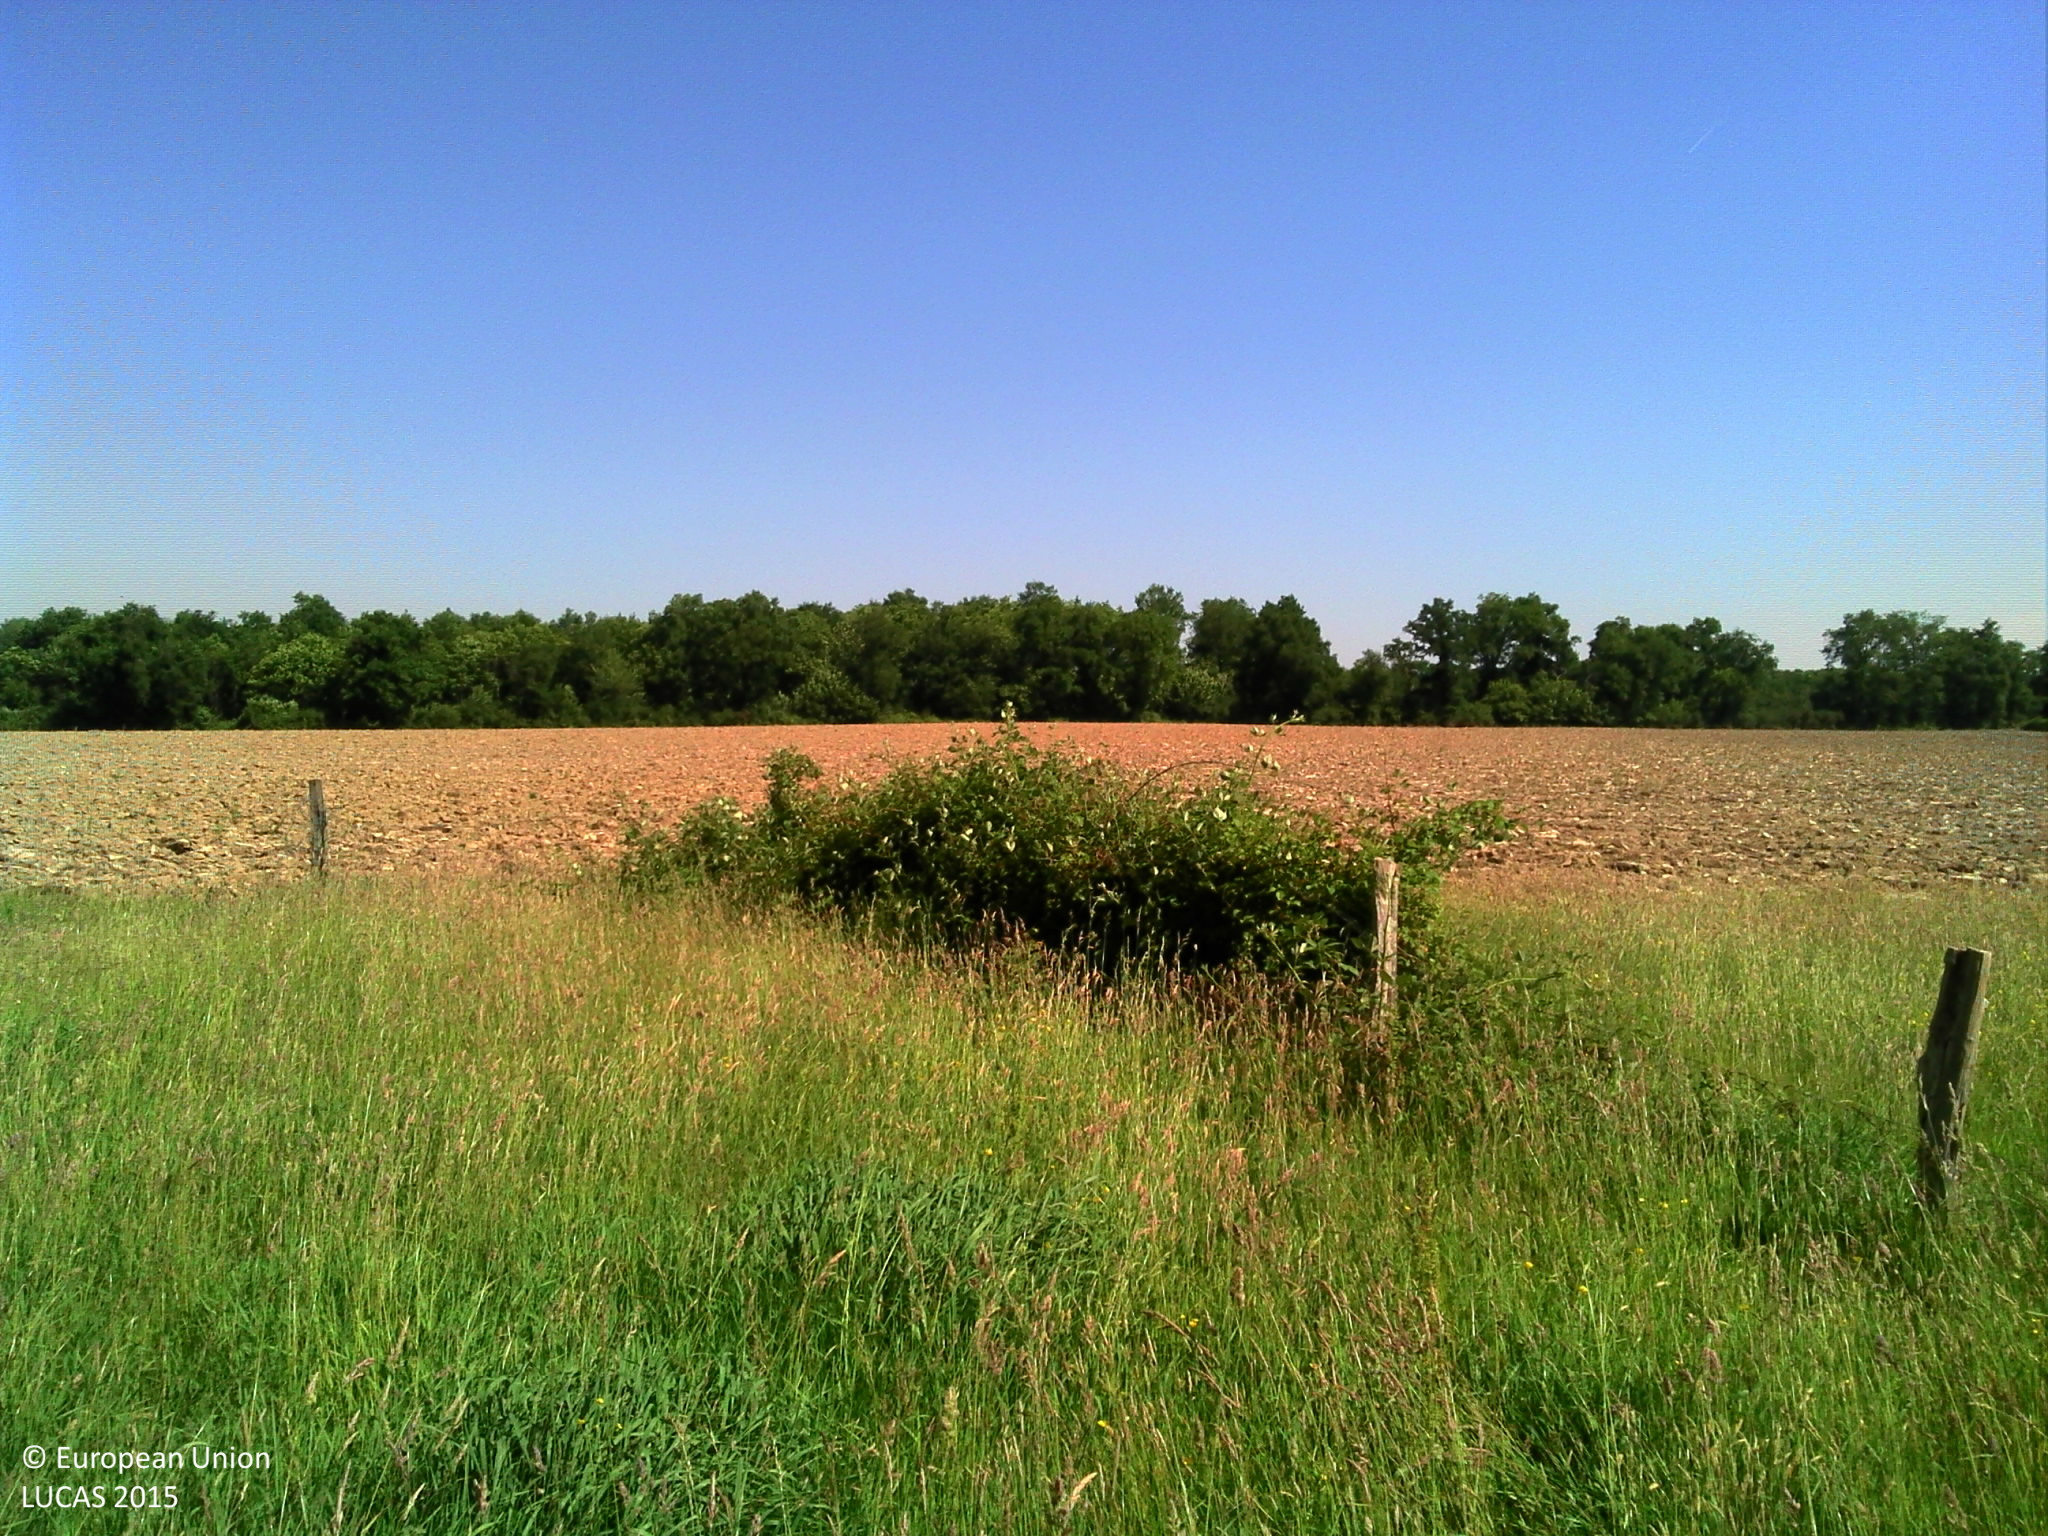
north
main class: Grassland
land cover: Grassland without tree/shrub cover
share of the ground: > 75 %
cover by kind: herbaceous plants 100 %
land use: Agriculture (excluding fallow land and kitchen gardens)
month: June
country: FR
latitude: 46.0466
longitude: 0.6160
